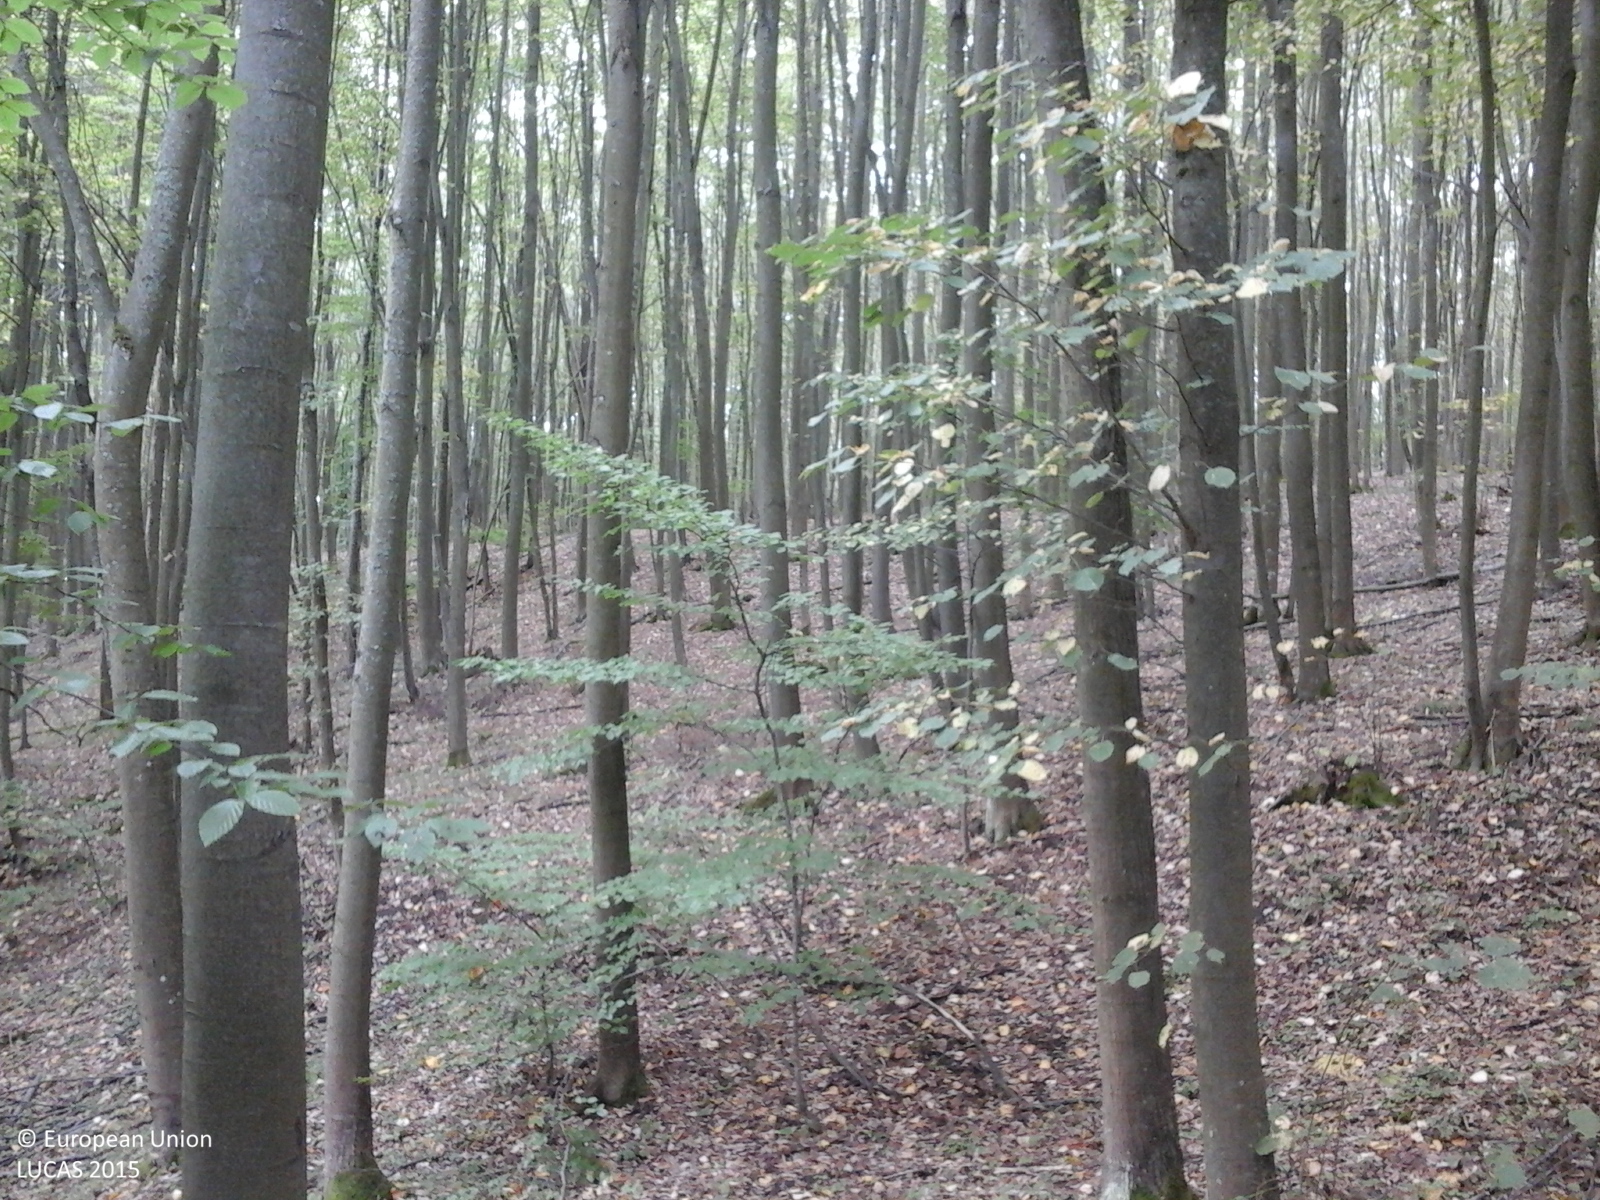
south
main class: Woodland
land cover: Broadleaved woodland
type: beech forest
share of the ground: > 75 %
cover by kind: broadleaved forest trees 100 %
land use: Forestry
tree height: > 5 m
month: September
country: RO
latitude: 45.9460
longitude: 21.9994
